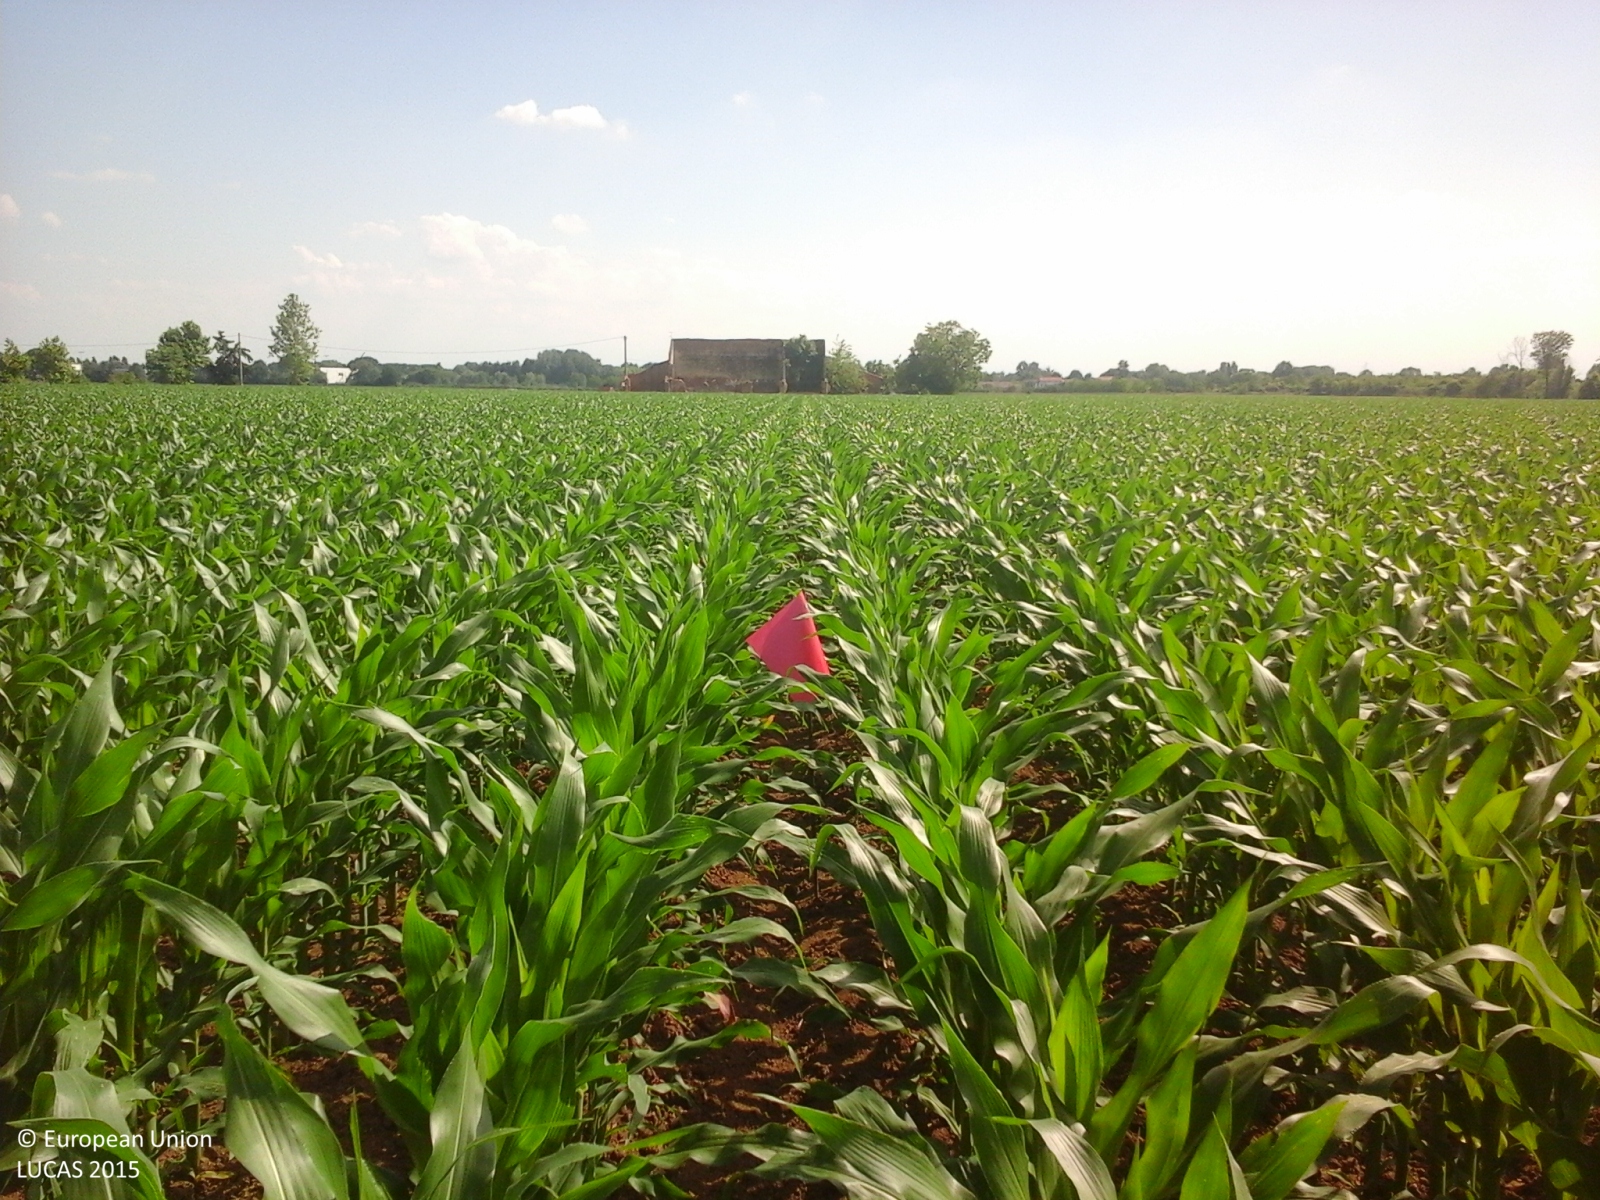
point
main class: Cropland
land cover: Maize
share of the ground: > 75 %
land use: Agriculture (excluding fallow land and kitchen gardens)
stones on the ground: < 10 %
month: May
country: IT
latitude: 45.1036
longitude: 10.9514
